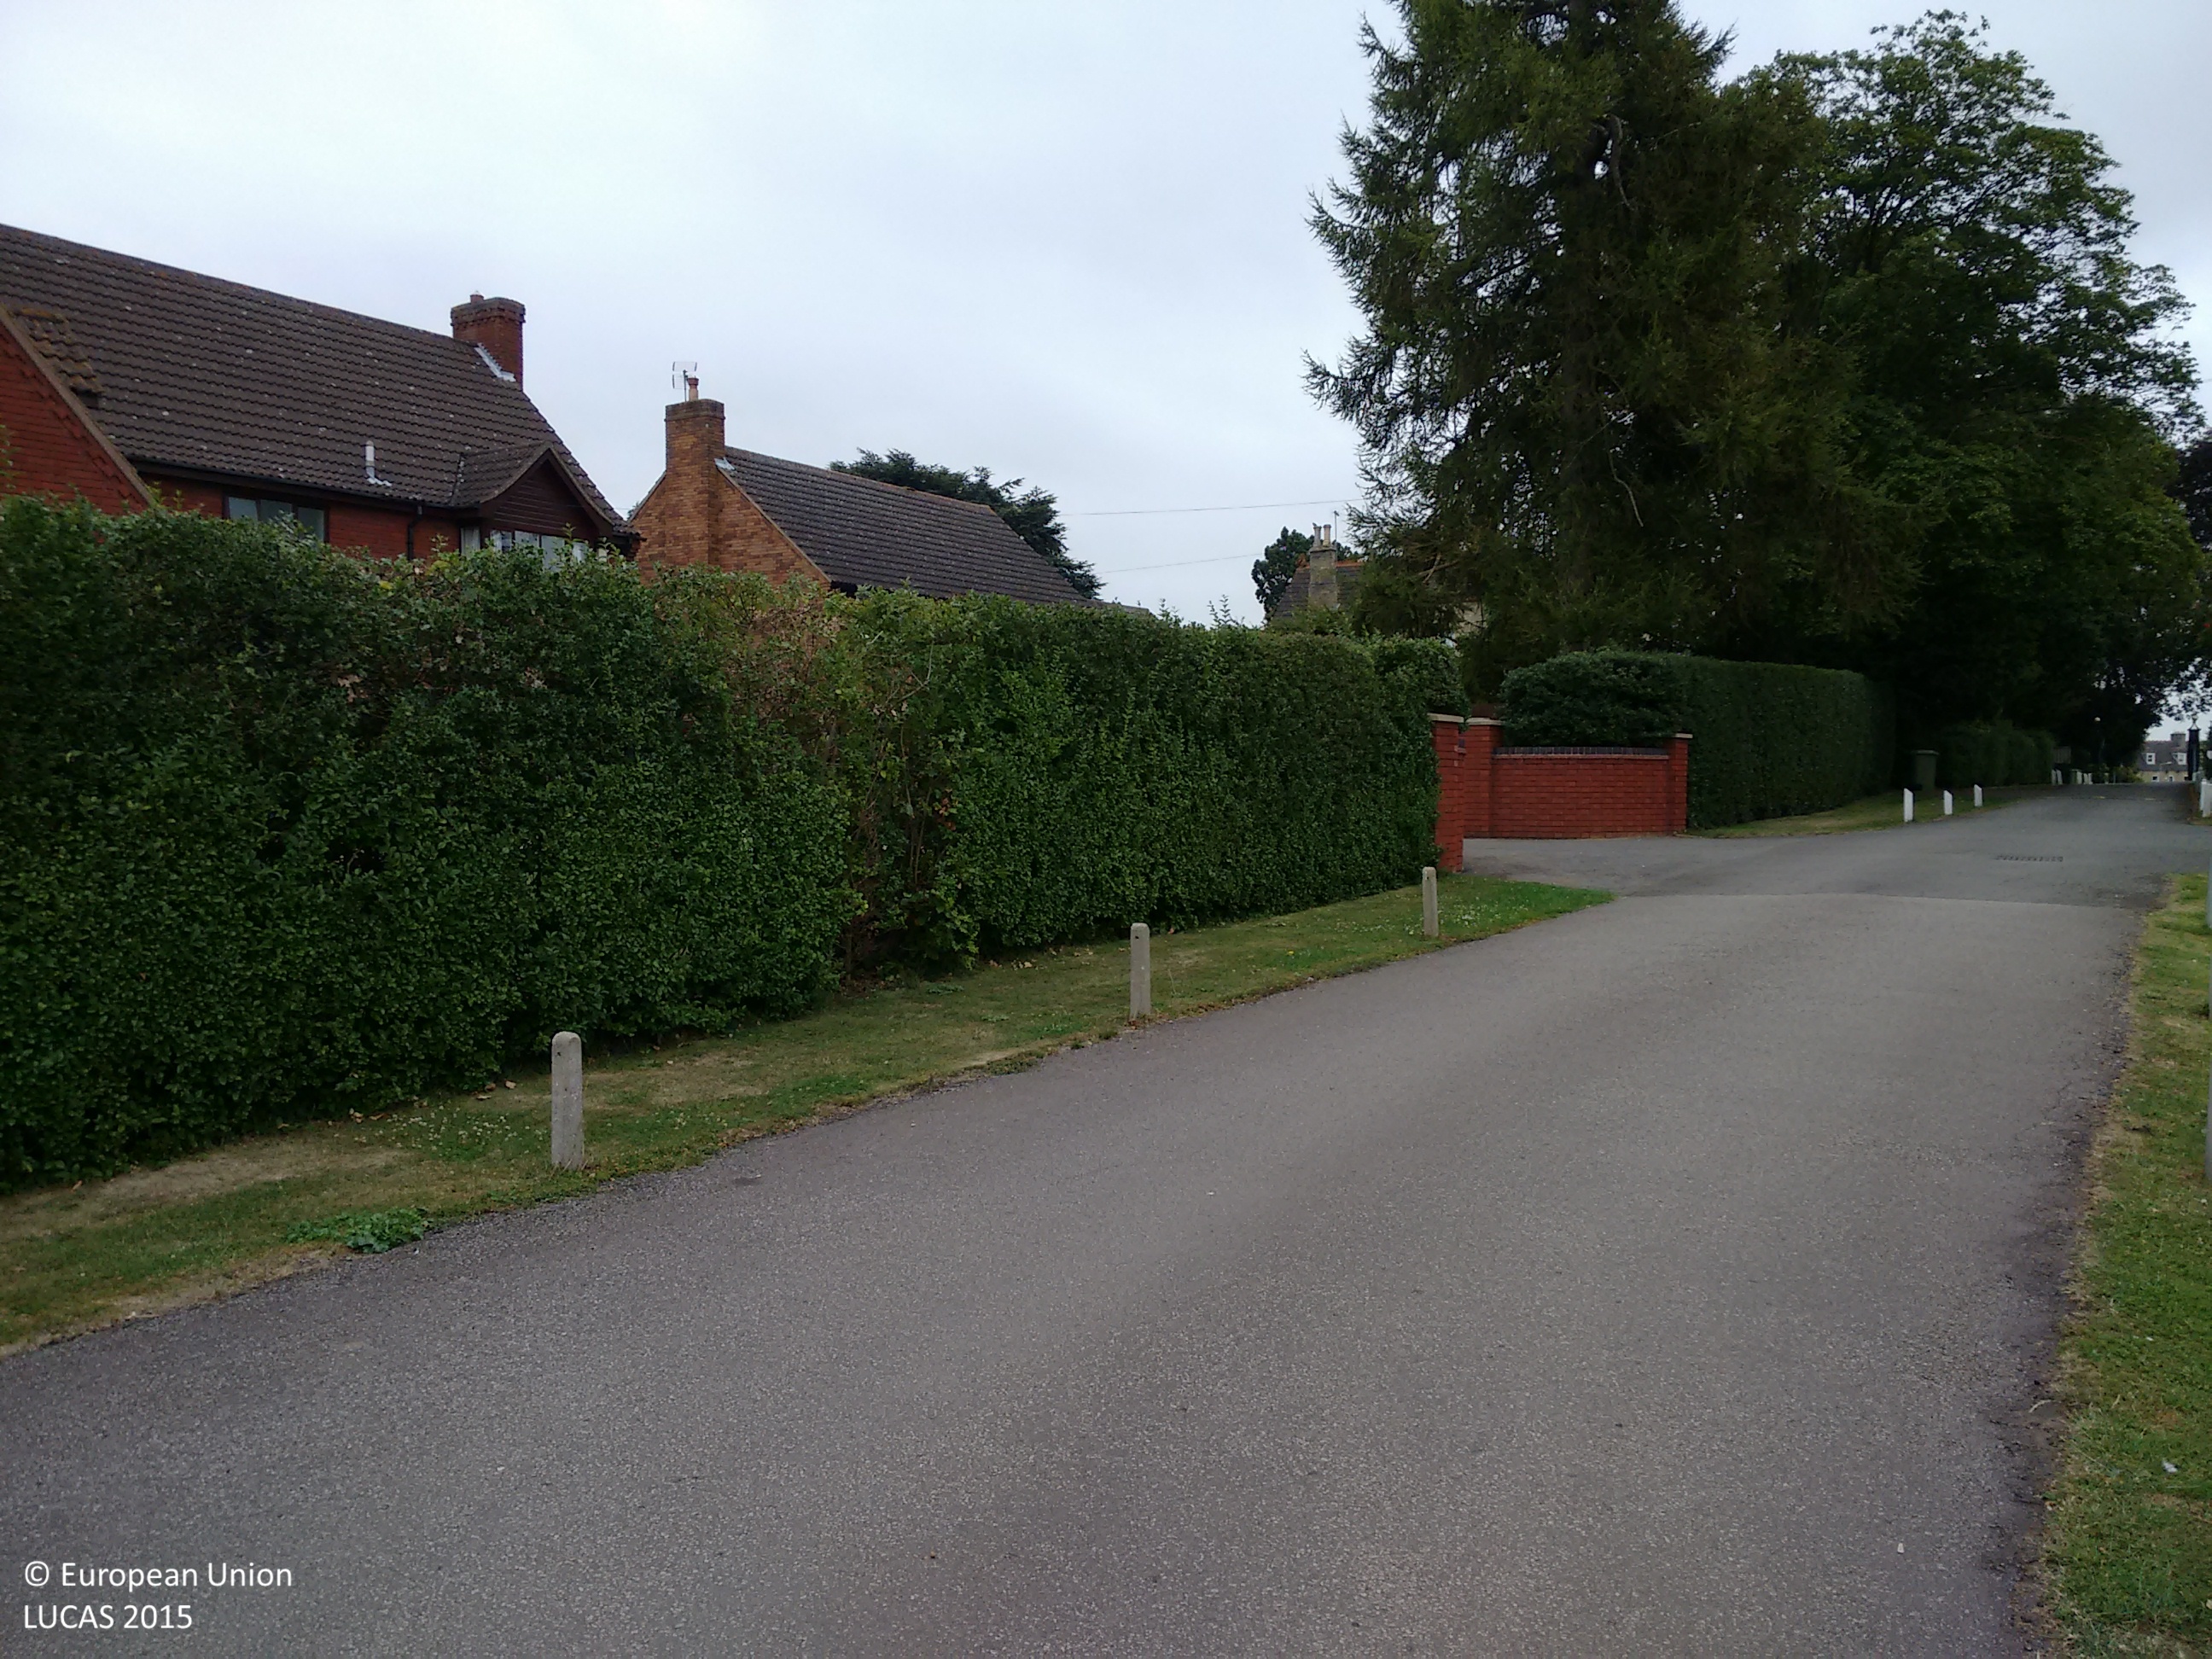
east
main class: Grassland
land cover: Grassland without tree/shrub cover
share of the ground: > 75 %
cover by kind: herbaceous plants 100 %
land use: Sport
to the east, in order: Grassland without tree/shrub cover; Artificial constructions in urban areas
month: August
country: GB
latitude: 52.3093
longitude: -0.7037
